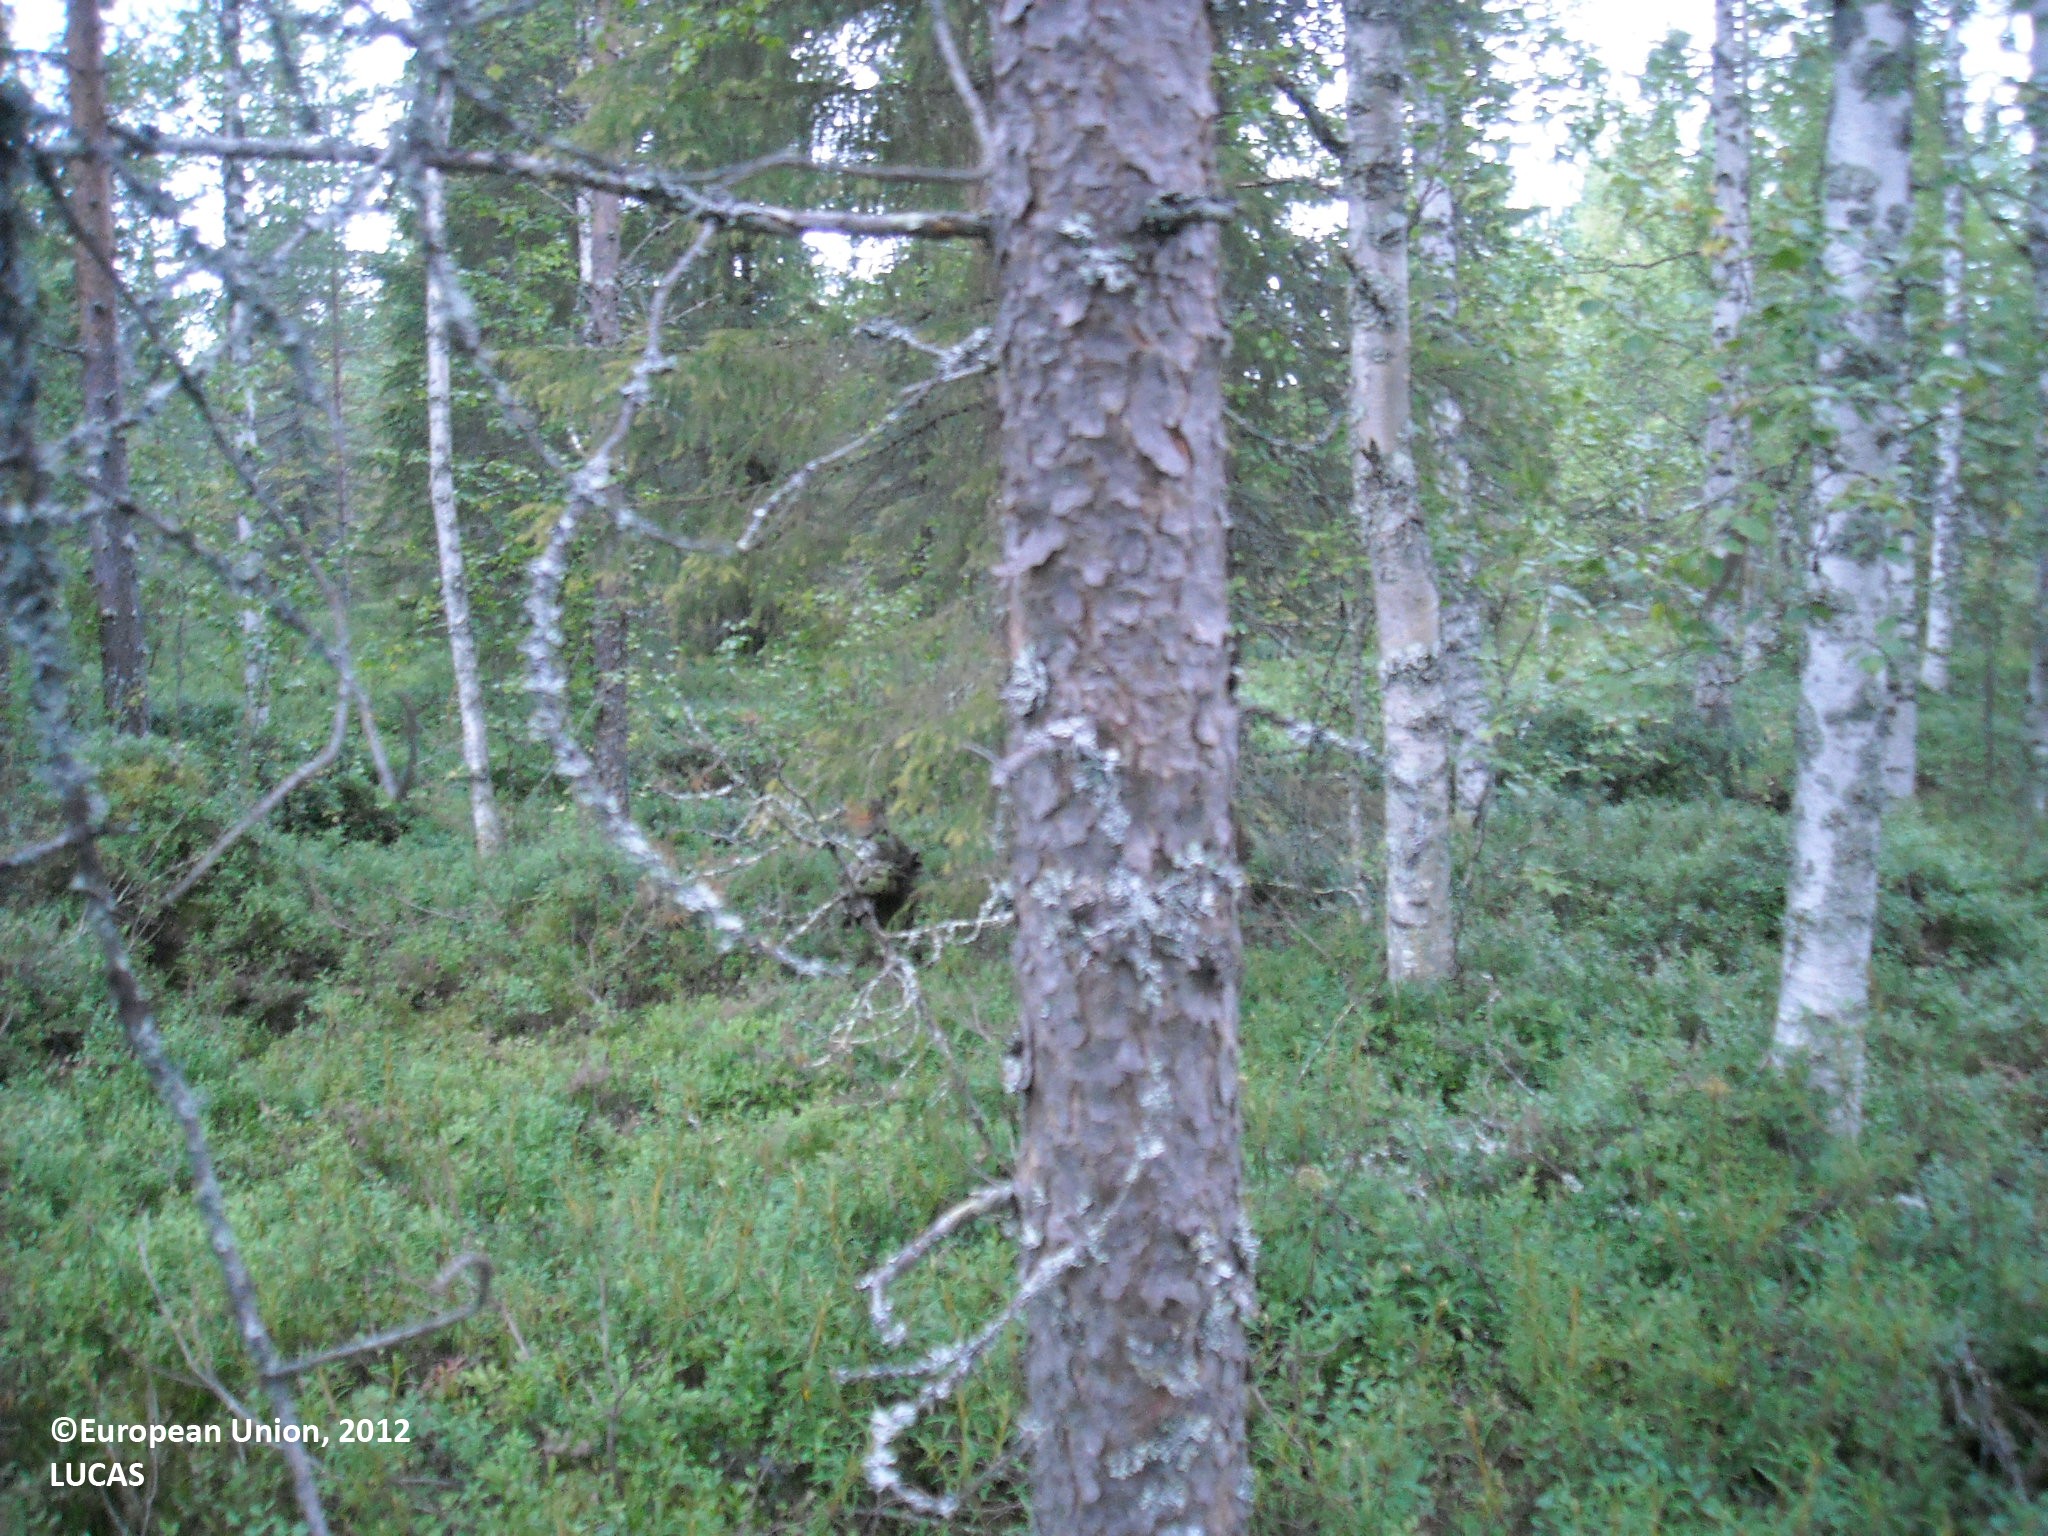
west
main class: Woodland
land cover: Other mixed woodland
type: mire and swamp forests
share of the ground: 50 - 75 %
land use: Forestry
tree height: > 5 m
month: August
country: FI
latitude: 65.1565
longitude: 27.5639
